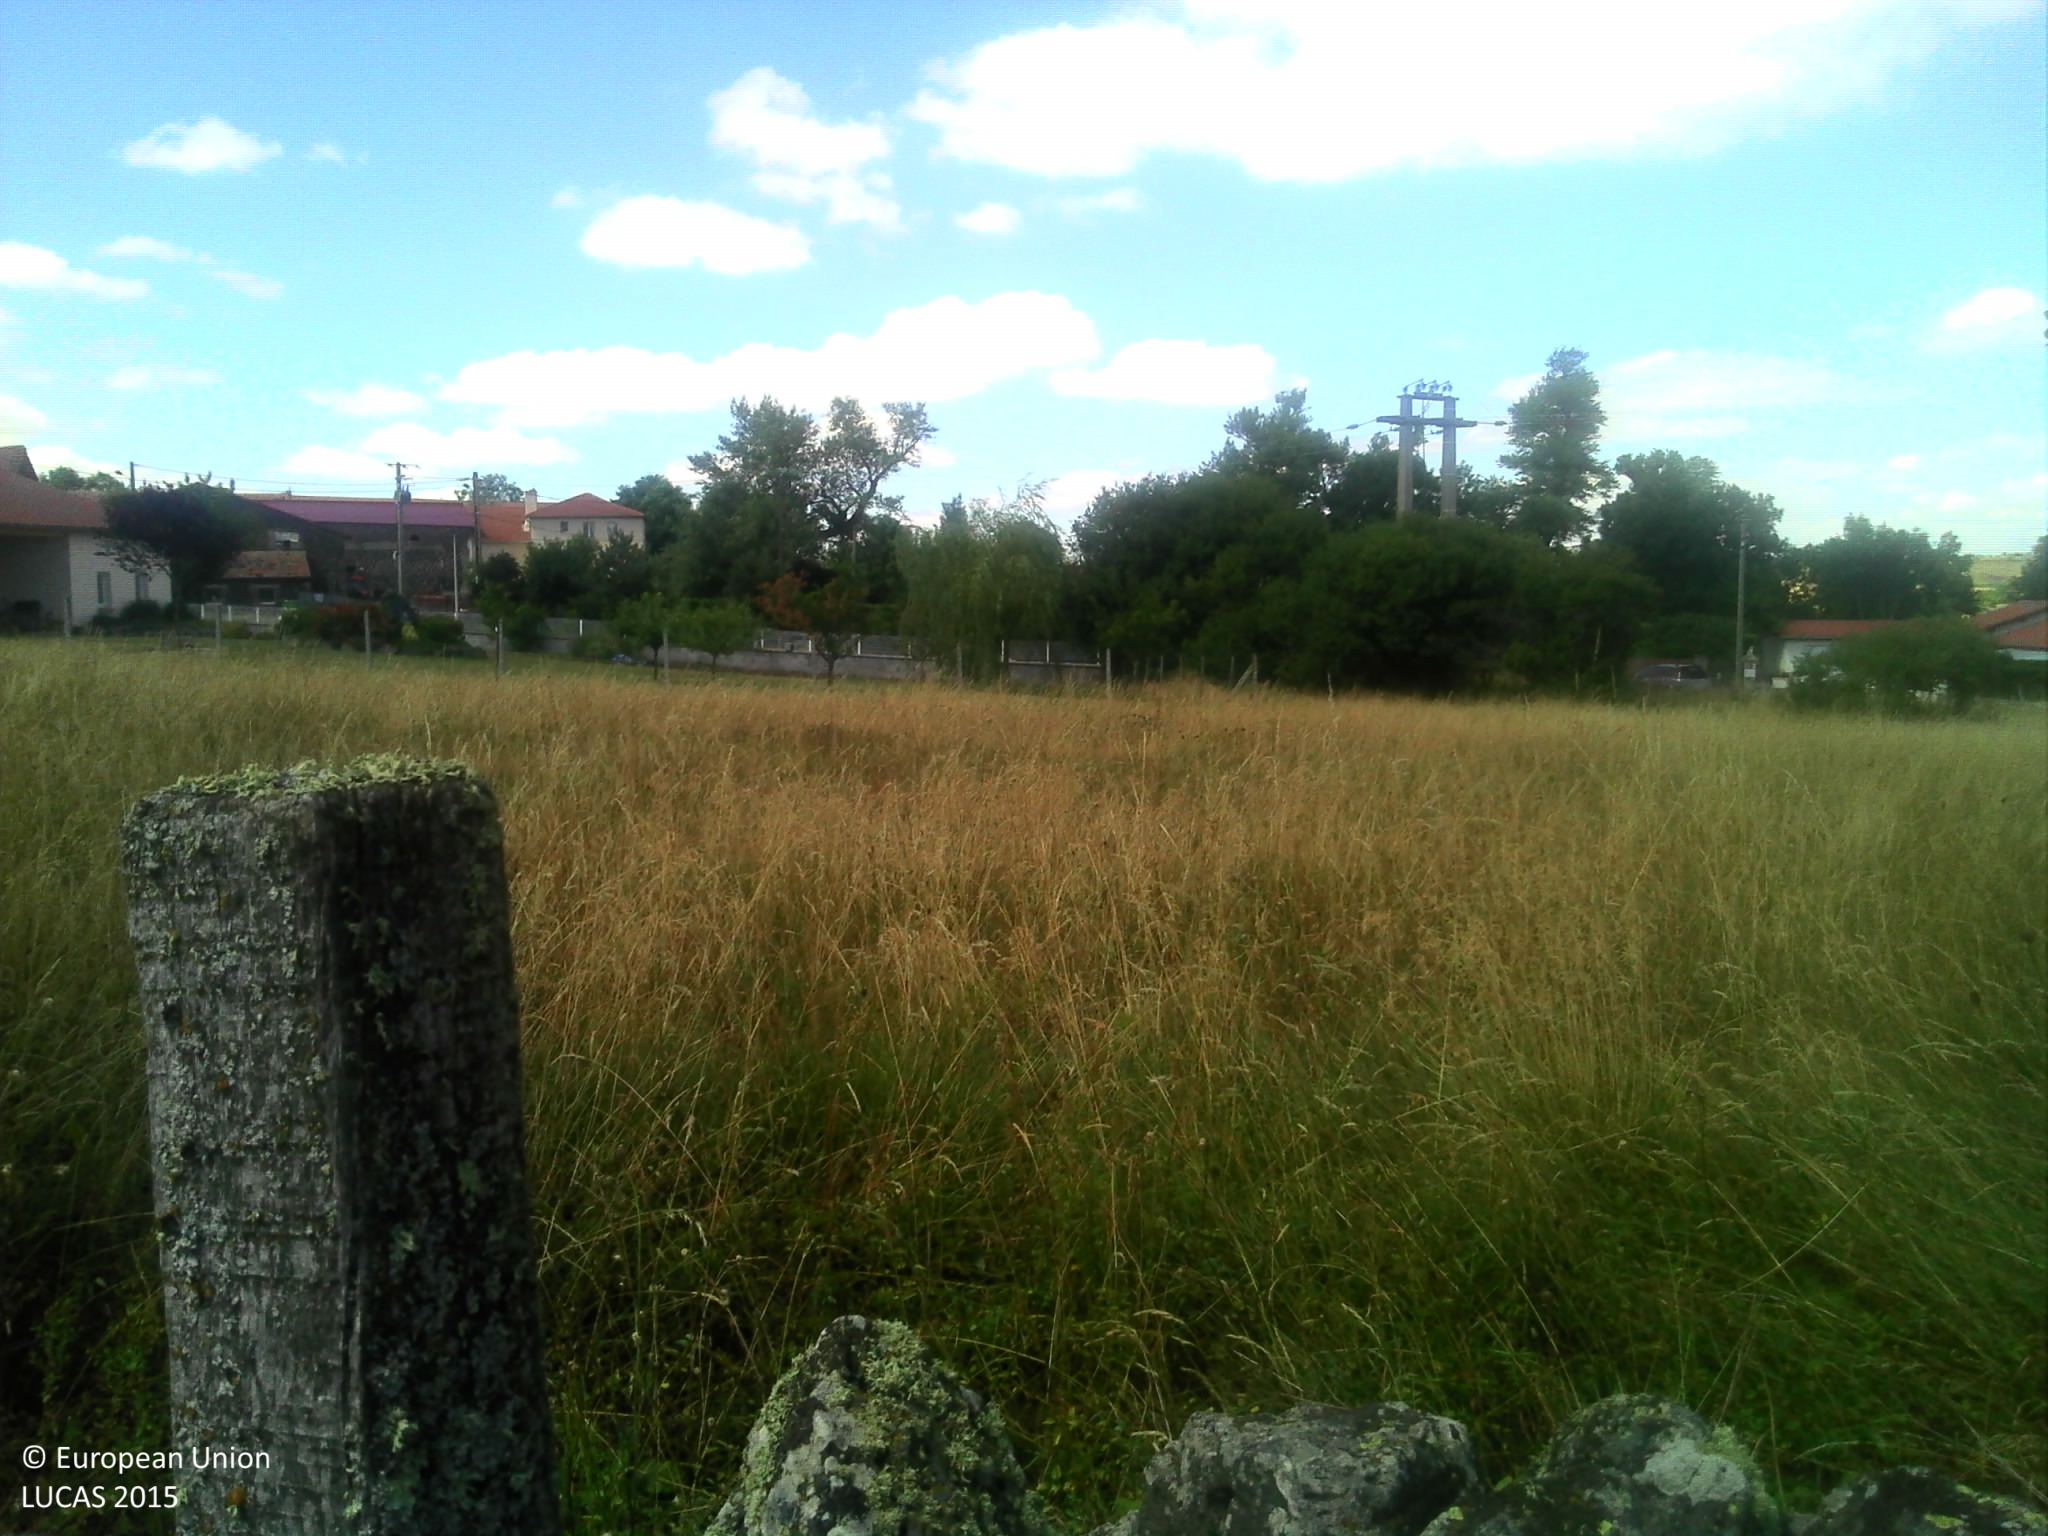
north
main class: Grassland
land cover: Grassland without tree/shrub cover
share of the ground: > 75 %
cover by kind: herbaceous plants 100 %
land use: Agriculture (excluding fallow land and kitchen gardens)
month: July
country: FR
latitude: 44.9265
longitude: 3.8343
